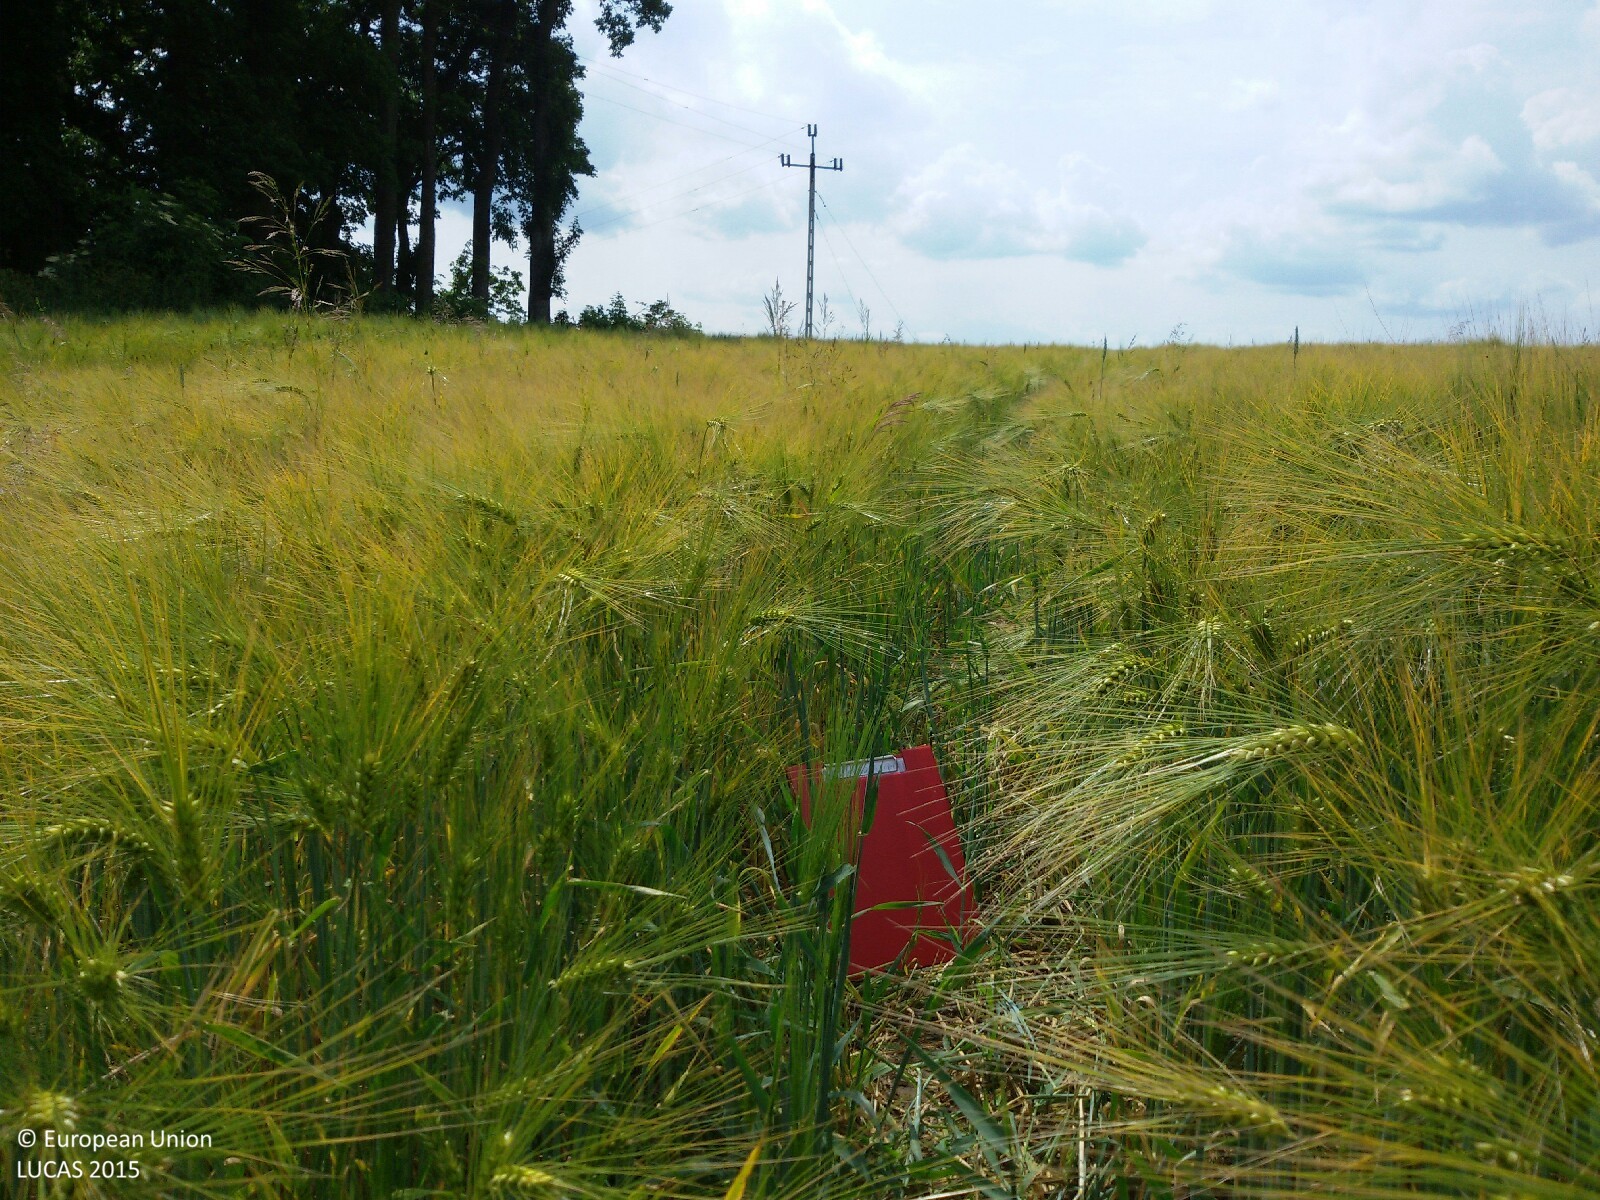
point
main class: Cropland
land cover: Barley
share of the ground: > 75 %
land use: Agriculture (excluding fallow land and kitchen gardens)
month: June
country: PL
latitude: 54.1852
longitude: 20.4094
